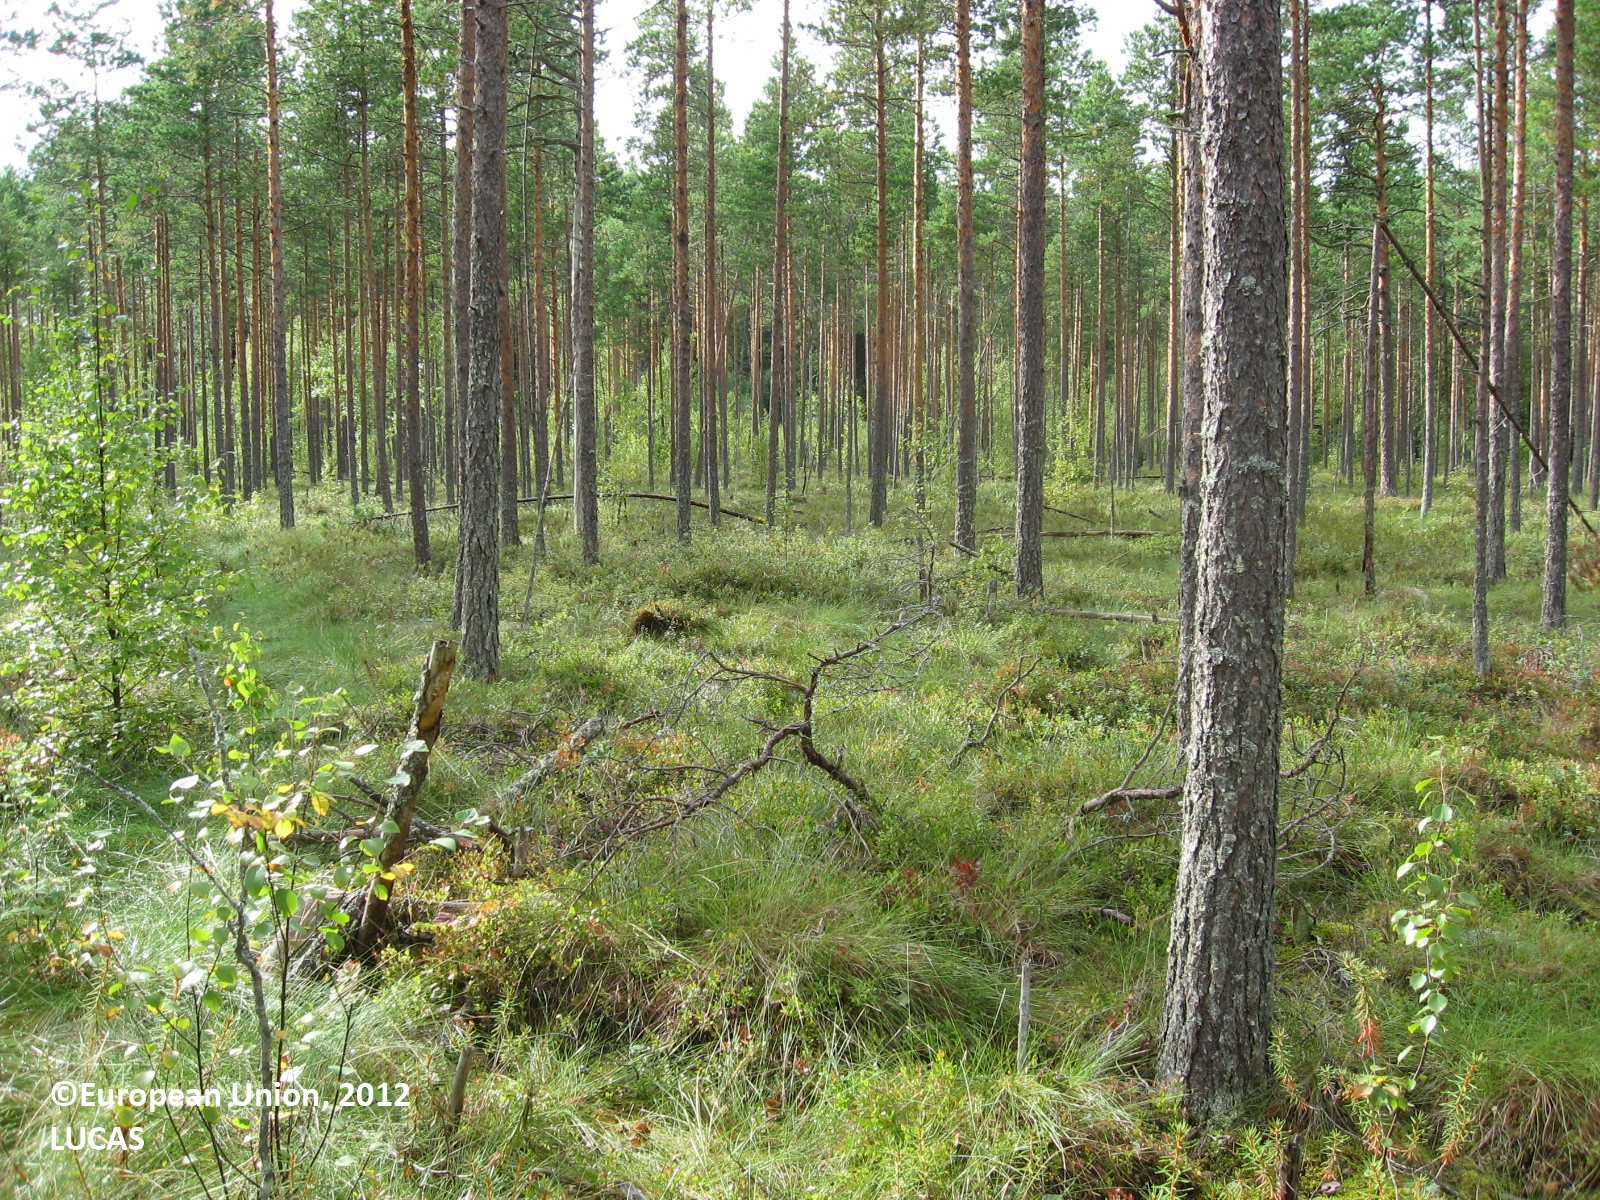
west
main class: Woodland
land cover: Pine dominated coniferous woodland
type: boreal forest
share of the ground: 50 - 75 %
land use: Forestry
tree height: > 5 m
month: August
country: FI
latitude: 61.5265
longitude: 24.7894
